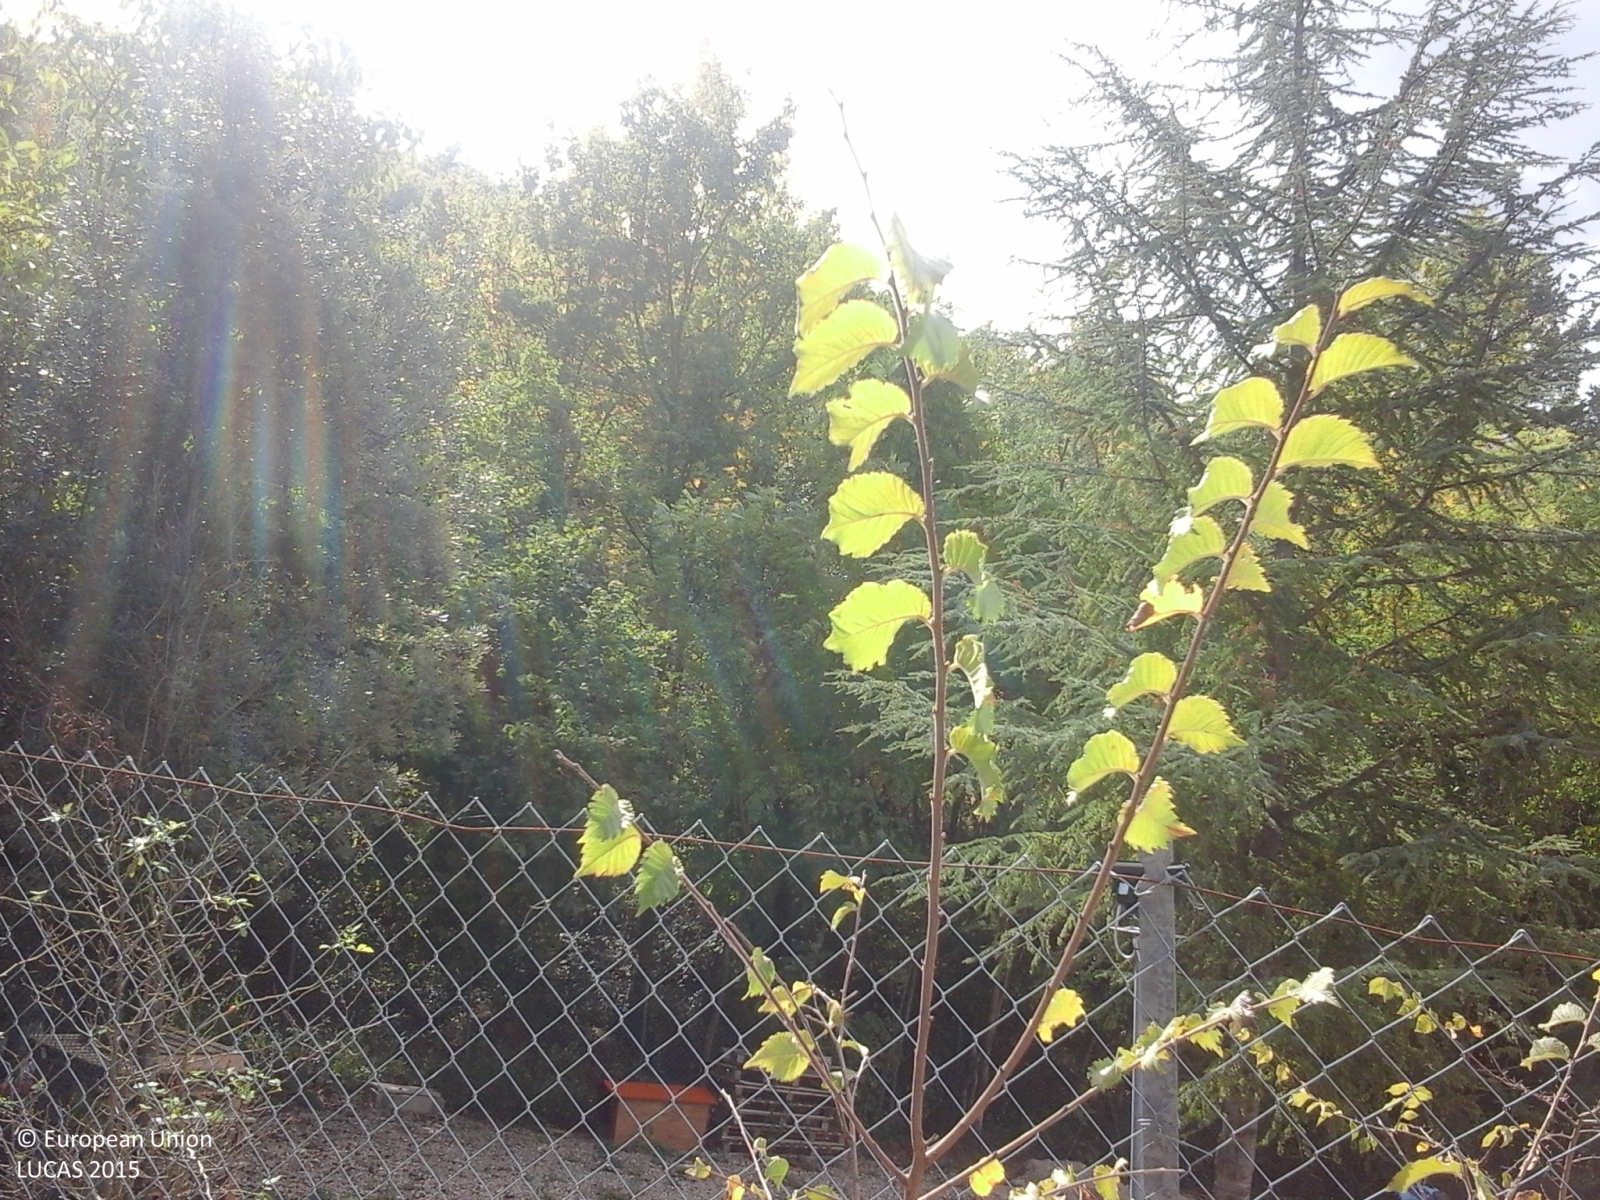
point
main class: Woodland
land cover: Broadleaved woodland
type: thermophilous deciduous forest
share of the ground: > 75 %
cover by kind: broadleaved forest trees 100 %
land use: Forestry
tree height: > 5 m
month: October
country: IT
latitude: 43.4411
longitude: 12.2796
